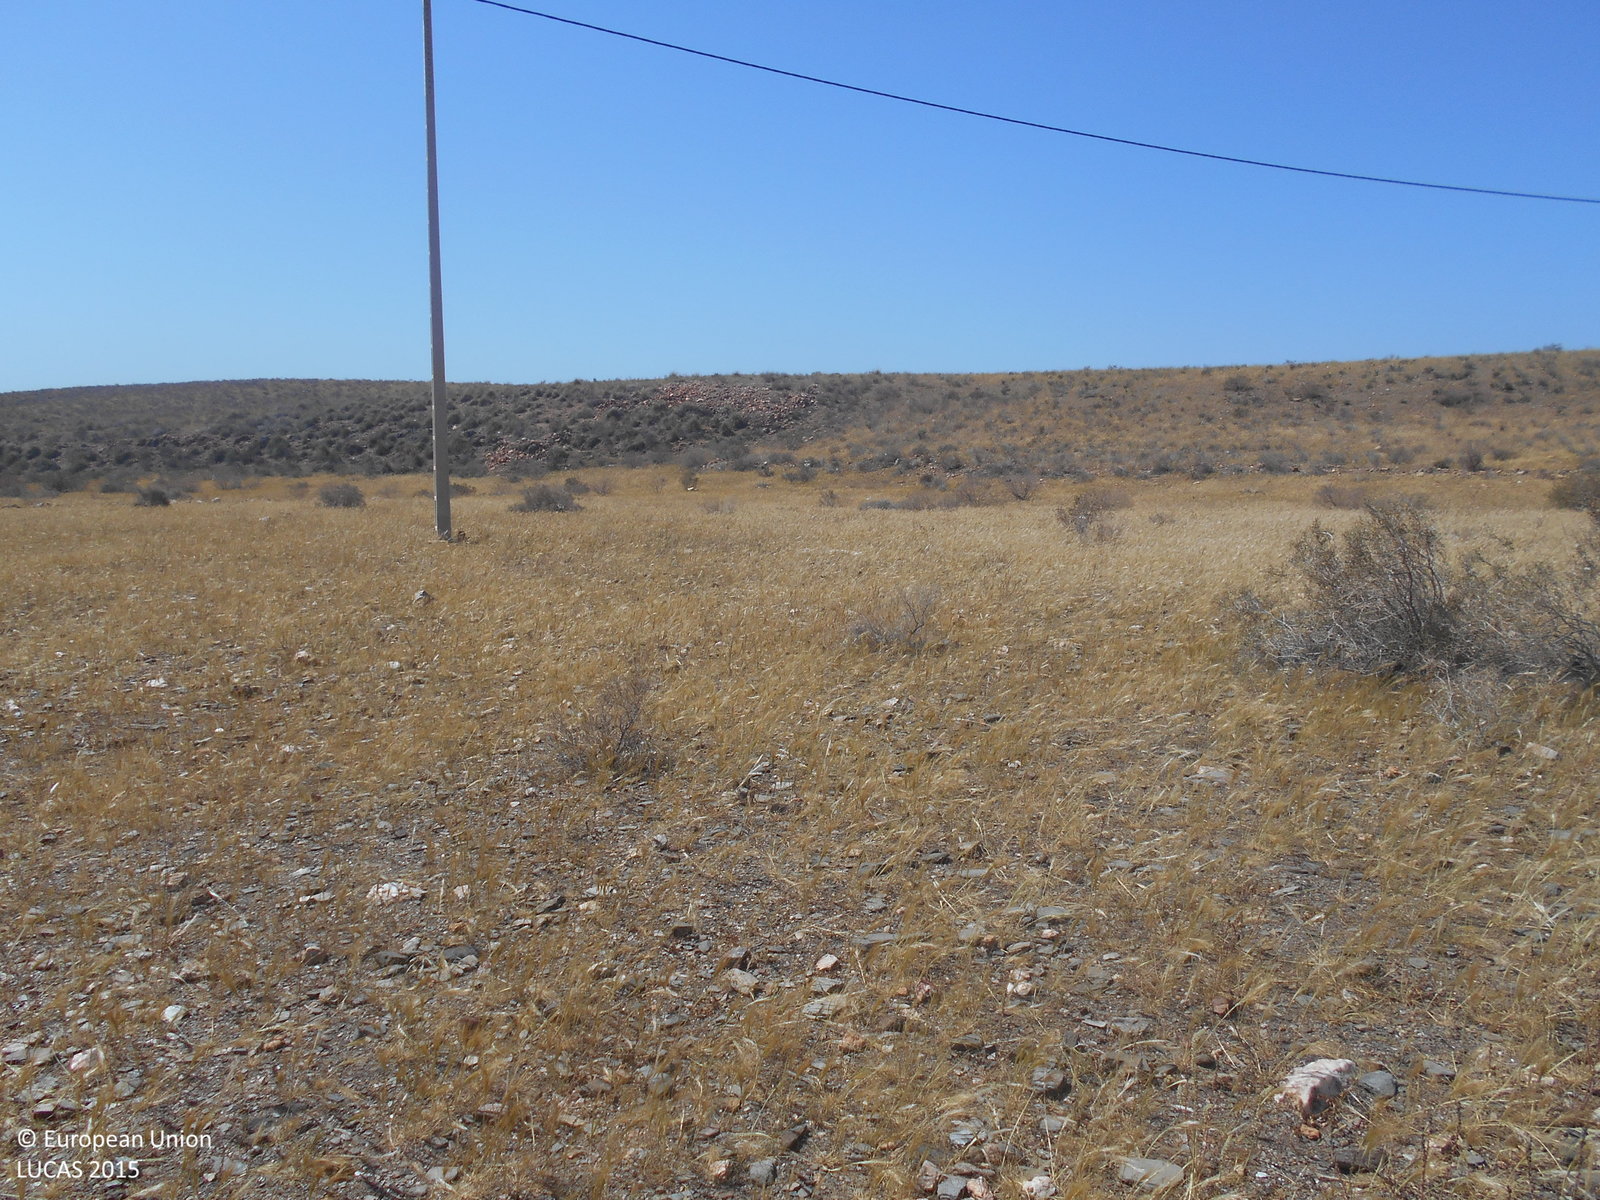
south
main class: Grassland
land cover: Grassland without tree/shrub cover
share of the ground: 50 - 75 %
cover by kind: herbaceous plants 60 %, unconsolidated bare surface 35 %, shrubs 5 %
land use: Semi-natural and natural areas not in use
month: May
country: ES
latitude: 37.4889
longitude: -1.4812
